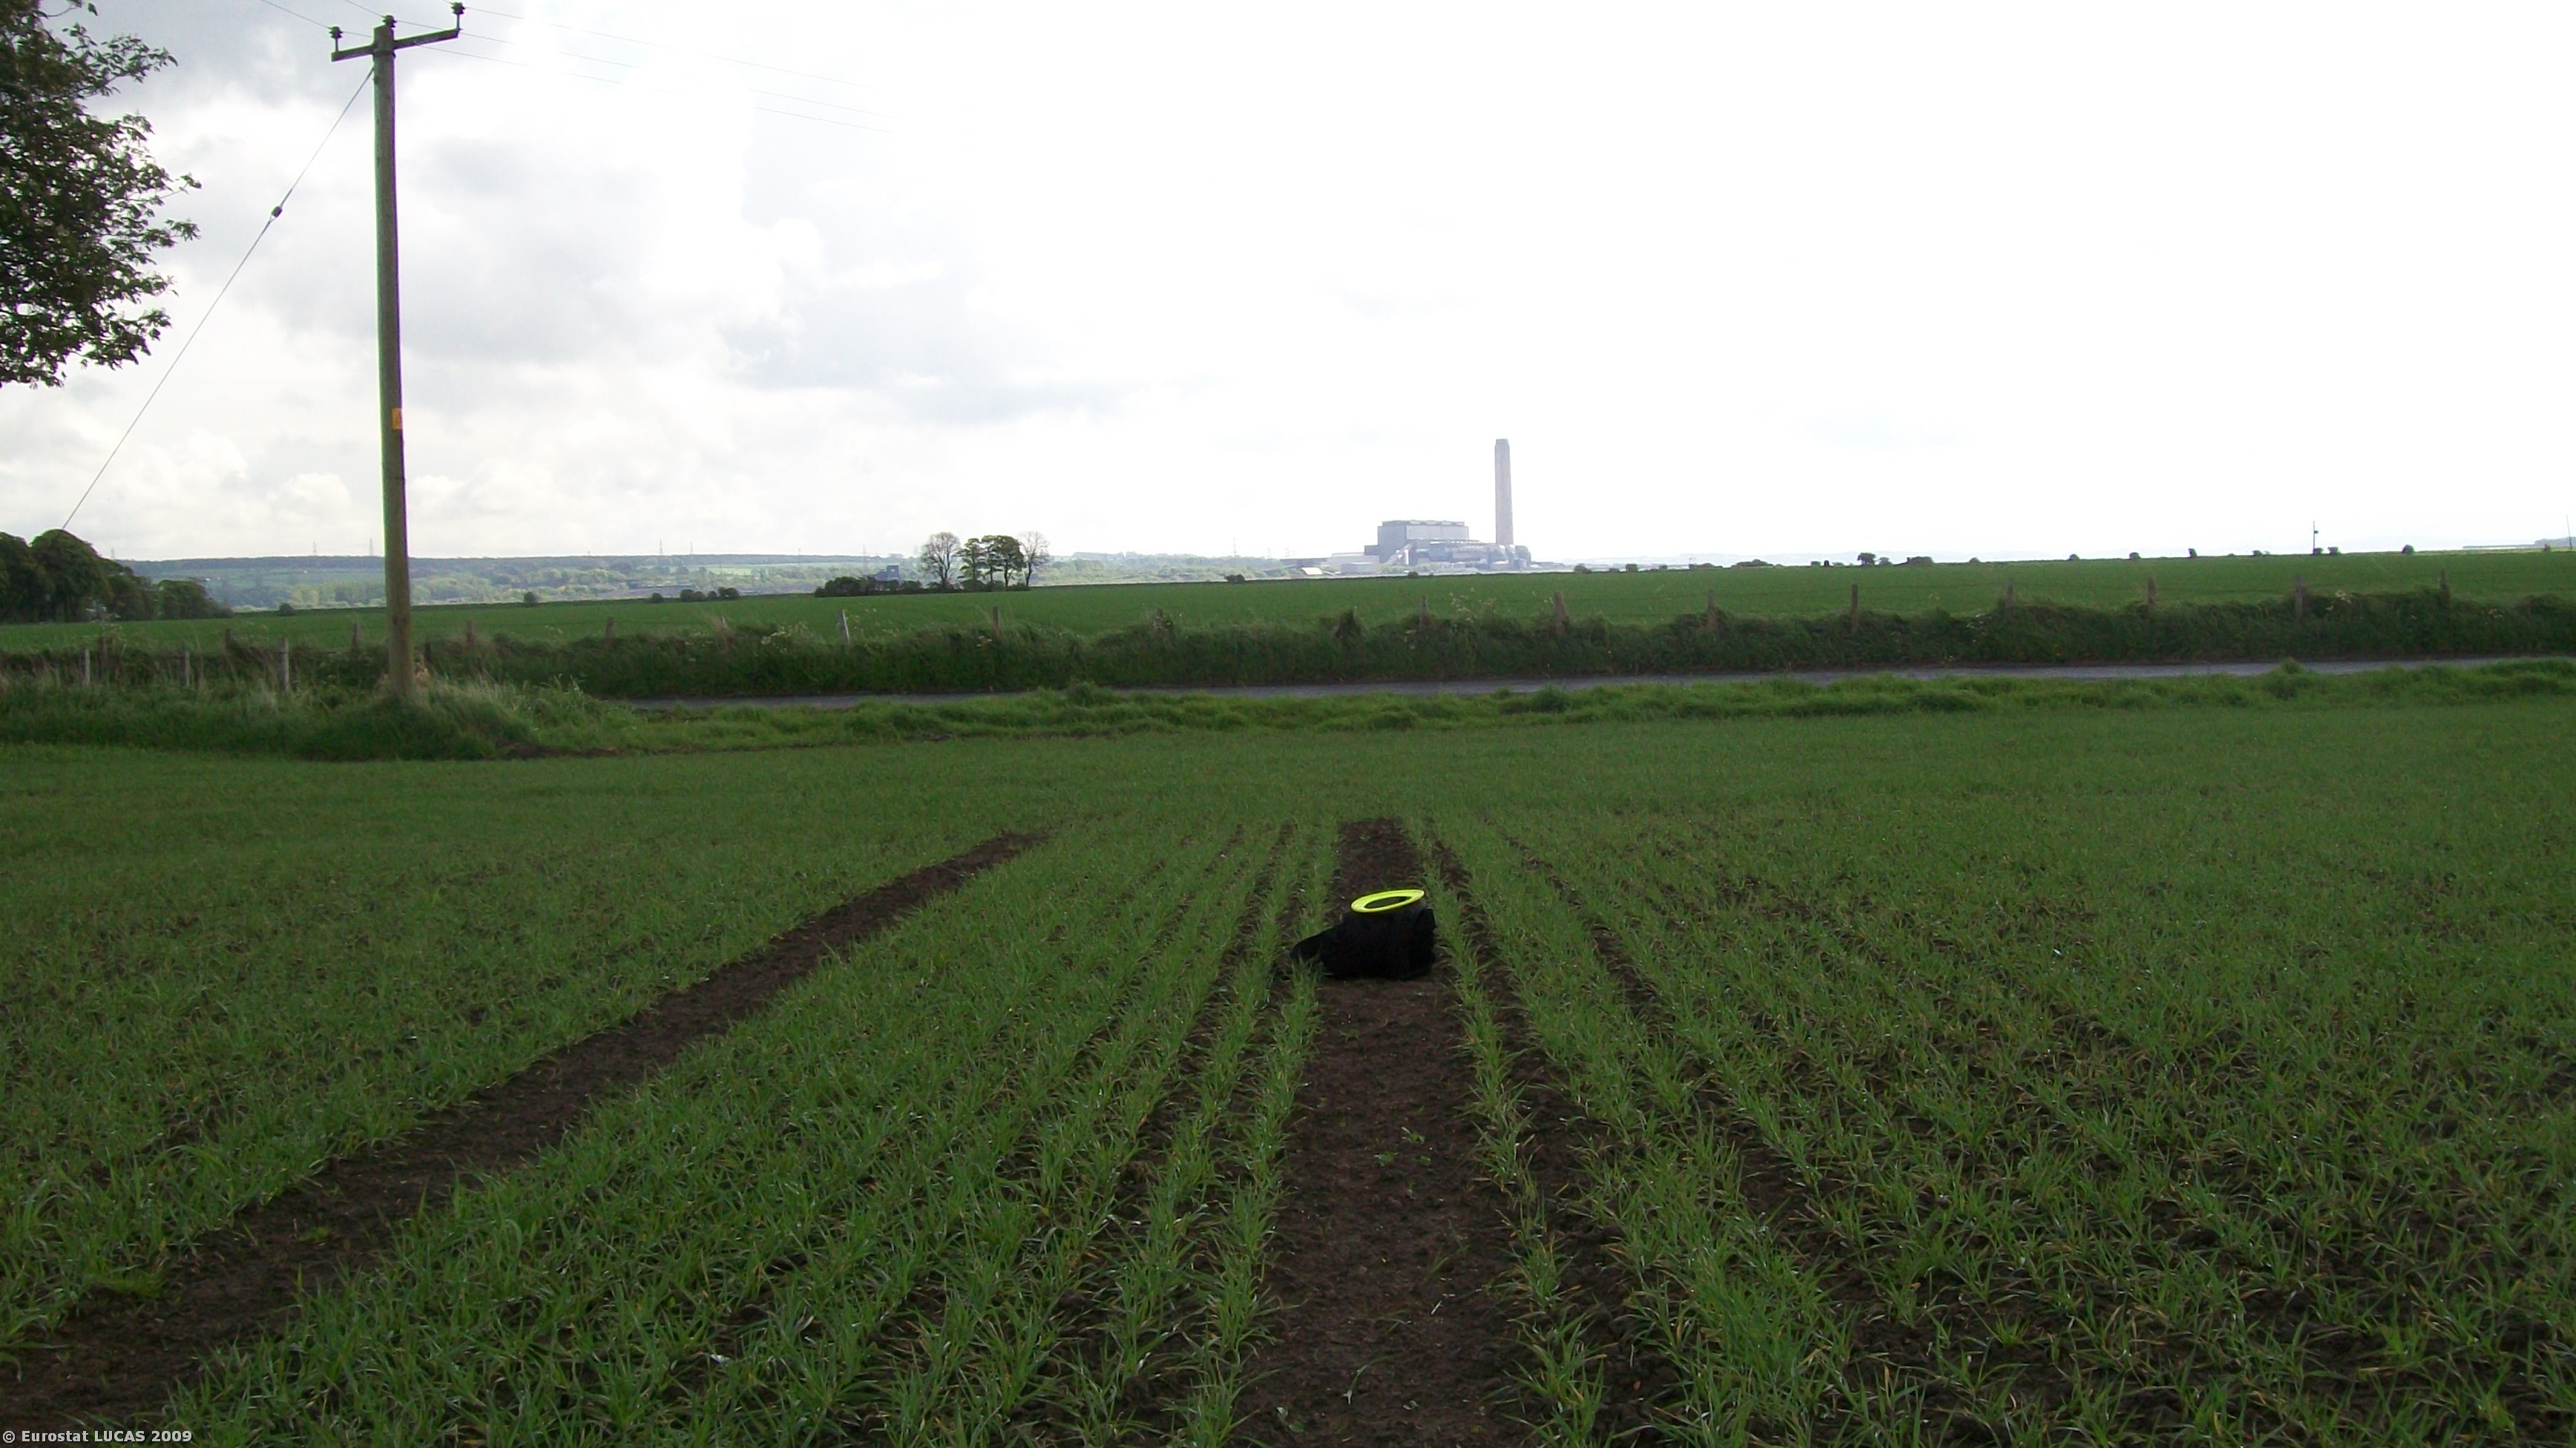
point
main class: Cropland
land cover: Barley
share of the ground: > 75 %
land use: Agriculture (excluding fallow land and kitchen gardens)
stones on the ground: < 10 %
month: May
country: GB
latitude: 56.0463
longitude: -3.7437
